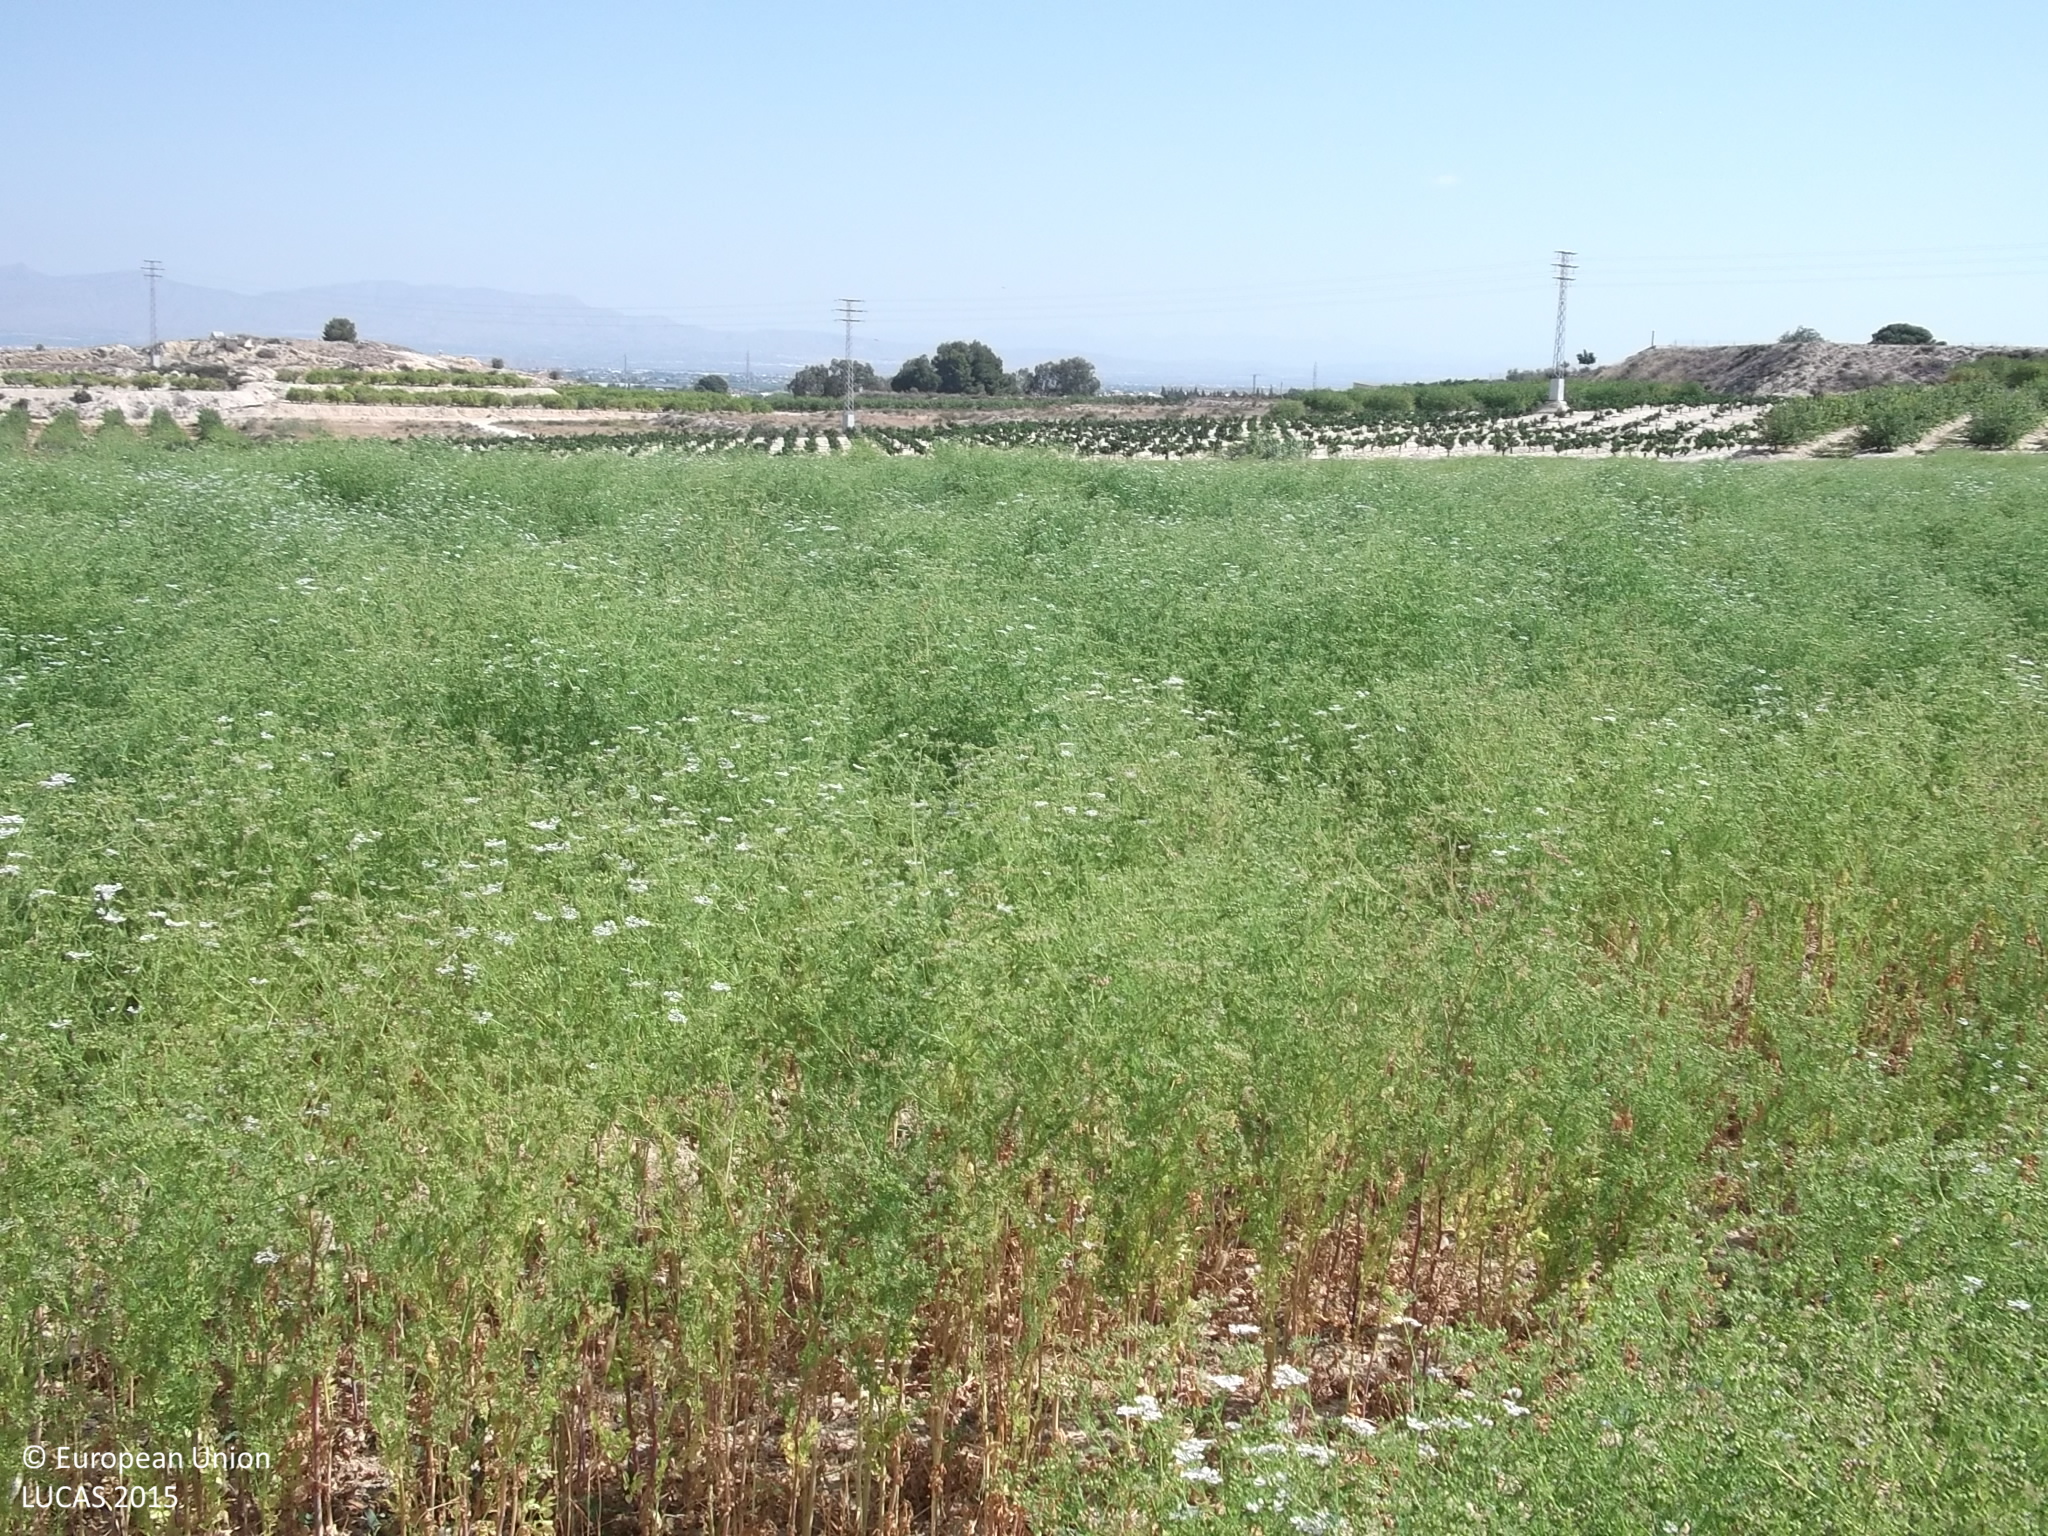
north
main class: Cropland
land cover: Other non-permanent industrial crops
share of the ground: > 75 %
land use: Agriculture (excluding fallow land and kitchen gardens)
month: May
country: ES
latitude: 38.0577
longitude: -0.8447
